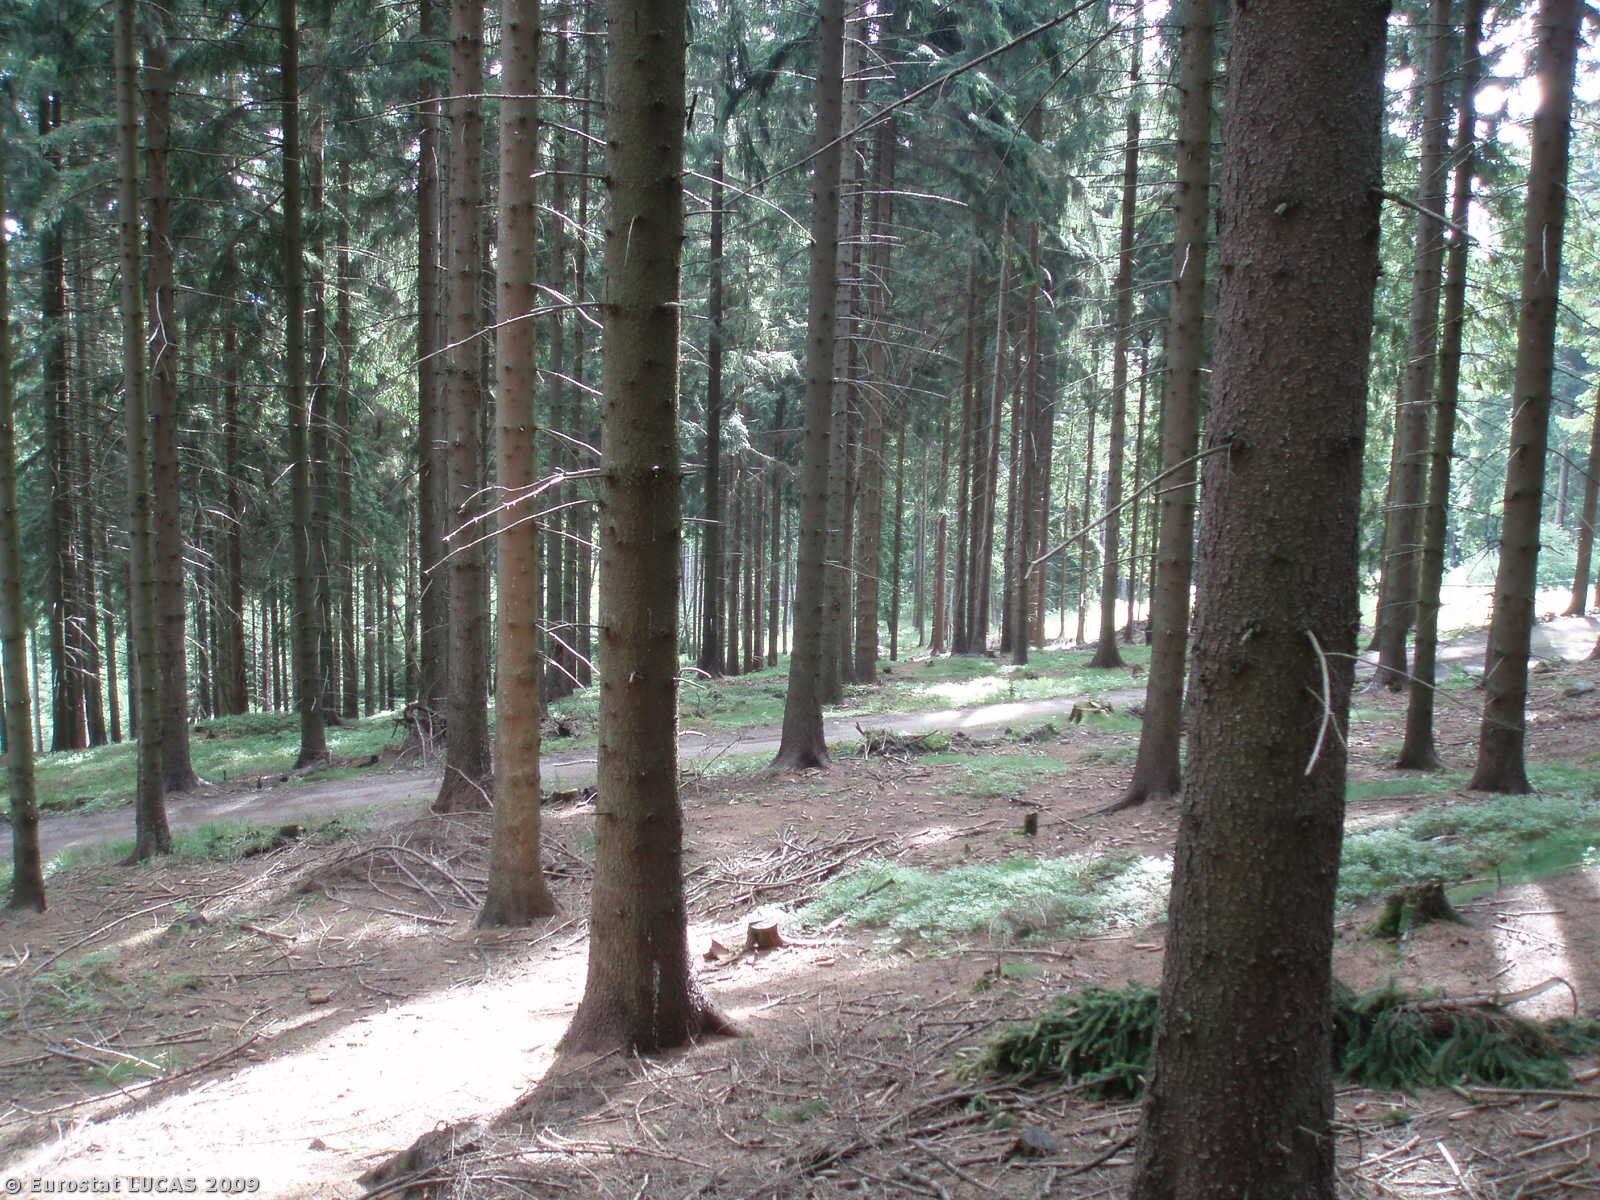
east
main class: Woodland
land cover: Coniferous woodland
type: hemiboreal forest and nemoral coniferous forest and mixed broadleaved-coniferous forest
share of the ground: > 75 %
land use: Forestry
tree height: > 5 m
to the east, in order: Coniferous woodland; Tracks; Coniferous woodland; Mixed woodland; Rivers and streams; Coniferous woodland
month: July
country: CZ
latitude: 50.7601
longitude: 14.9788
